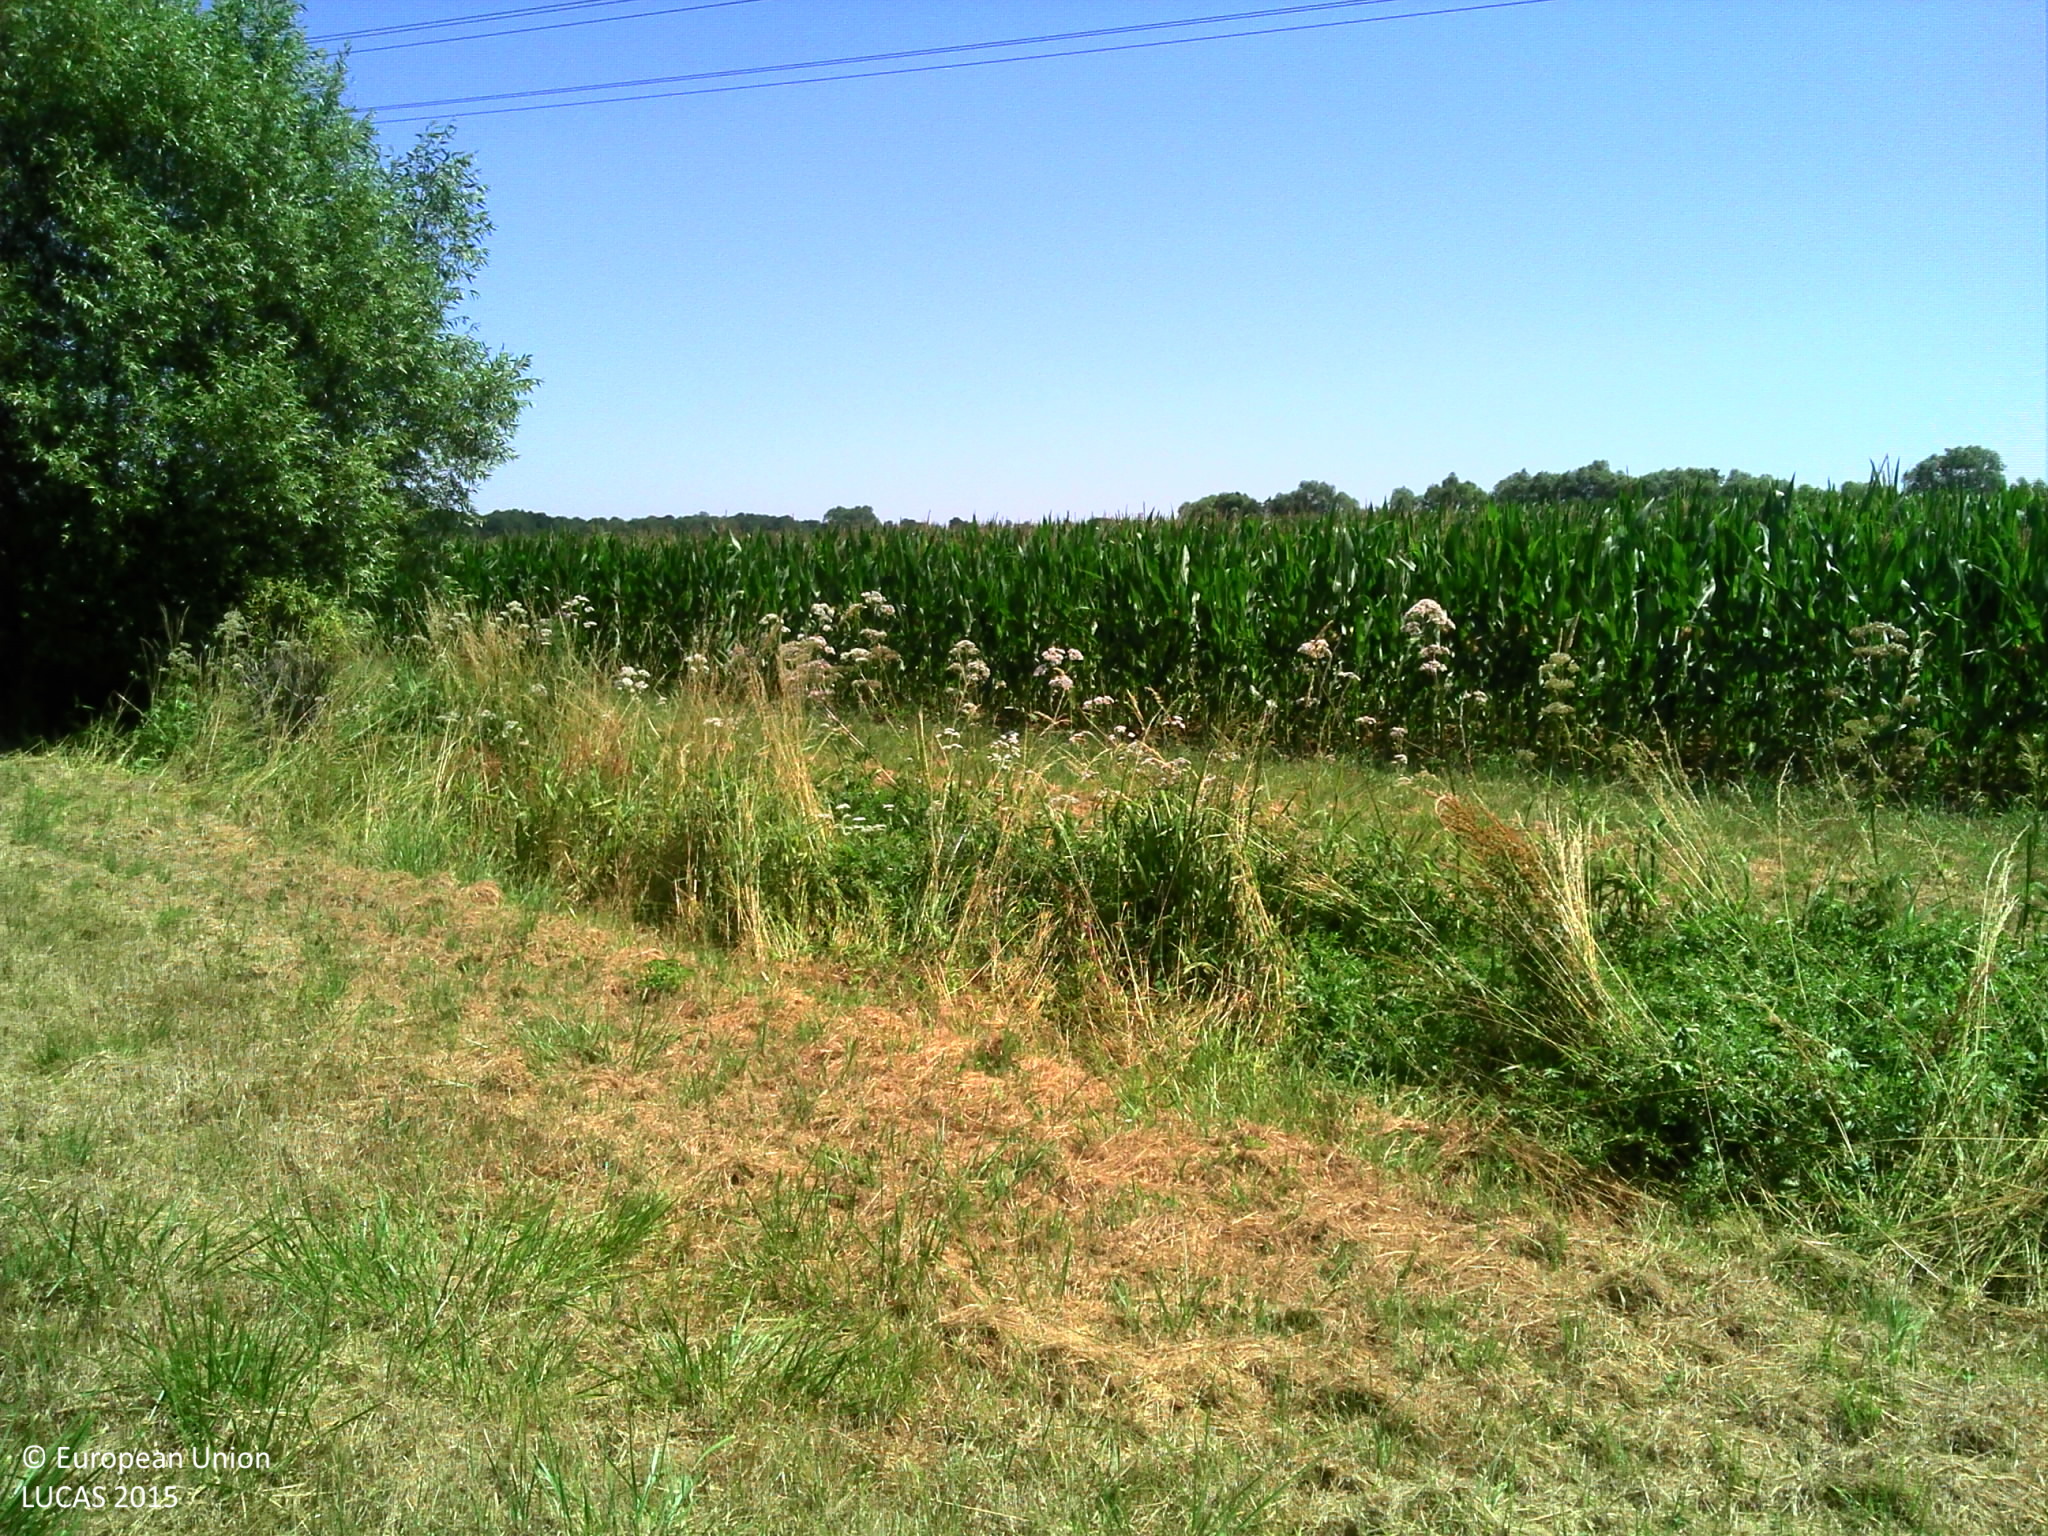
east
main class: Cropland
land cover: Maize
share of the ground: > 75 %
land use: Agriculture (excluding fallow land and kitchen gardens)
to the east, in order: Maize; Grassland without tree/shrub cover; Rivers and streams; Grassland without tree/shrub cover; Maize; Electric lines; Maize
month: July
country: FR
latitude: 48.8954
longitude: 6.1669
